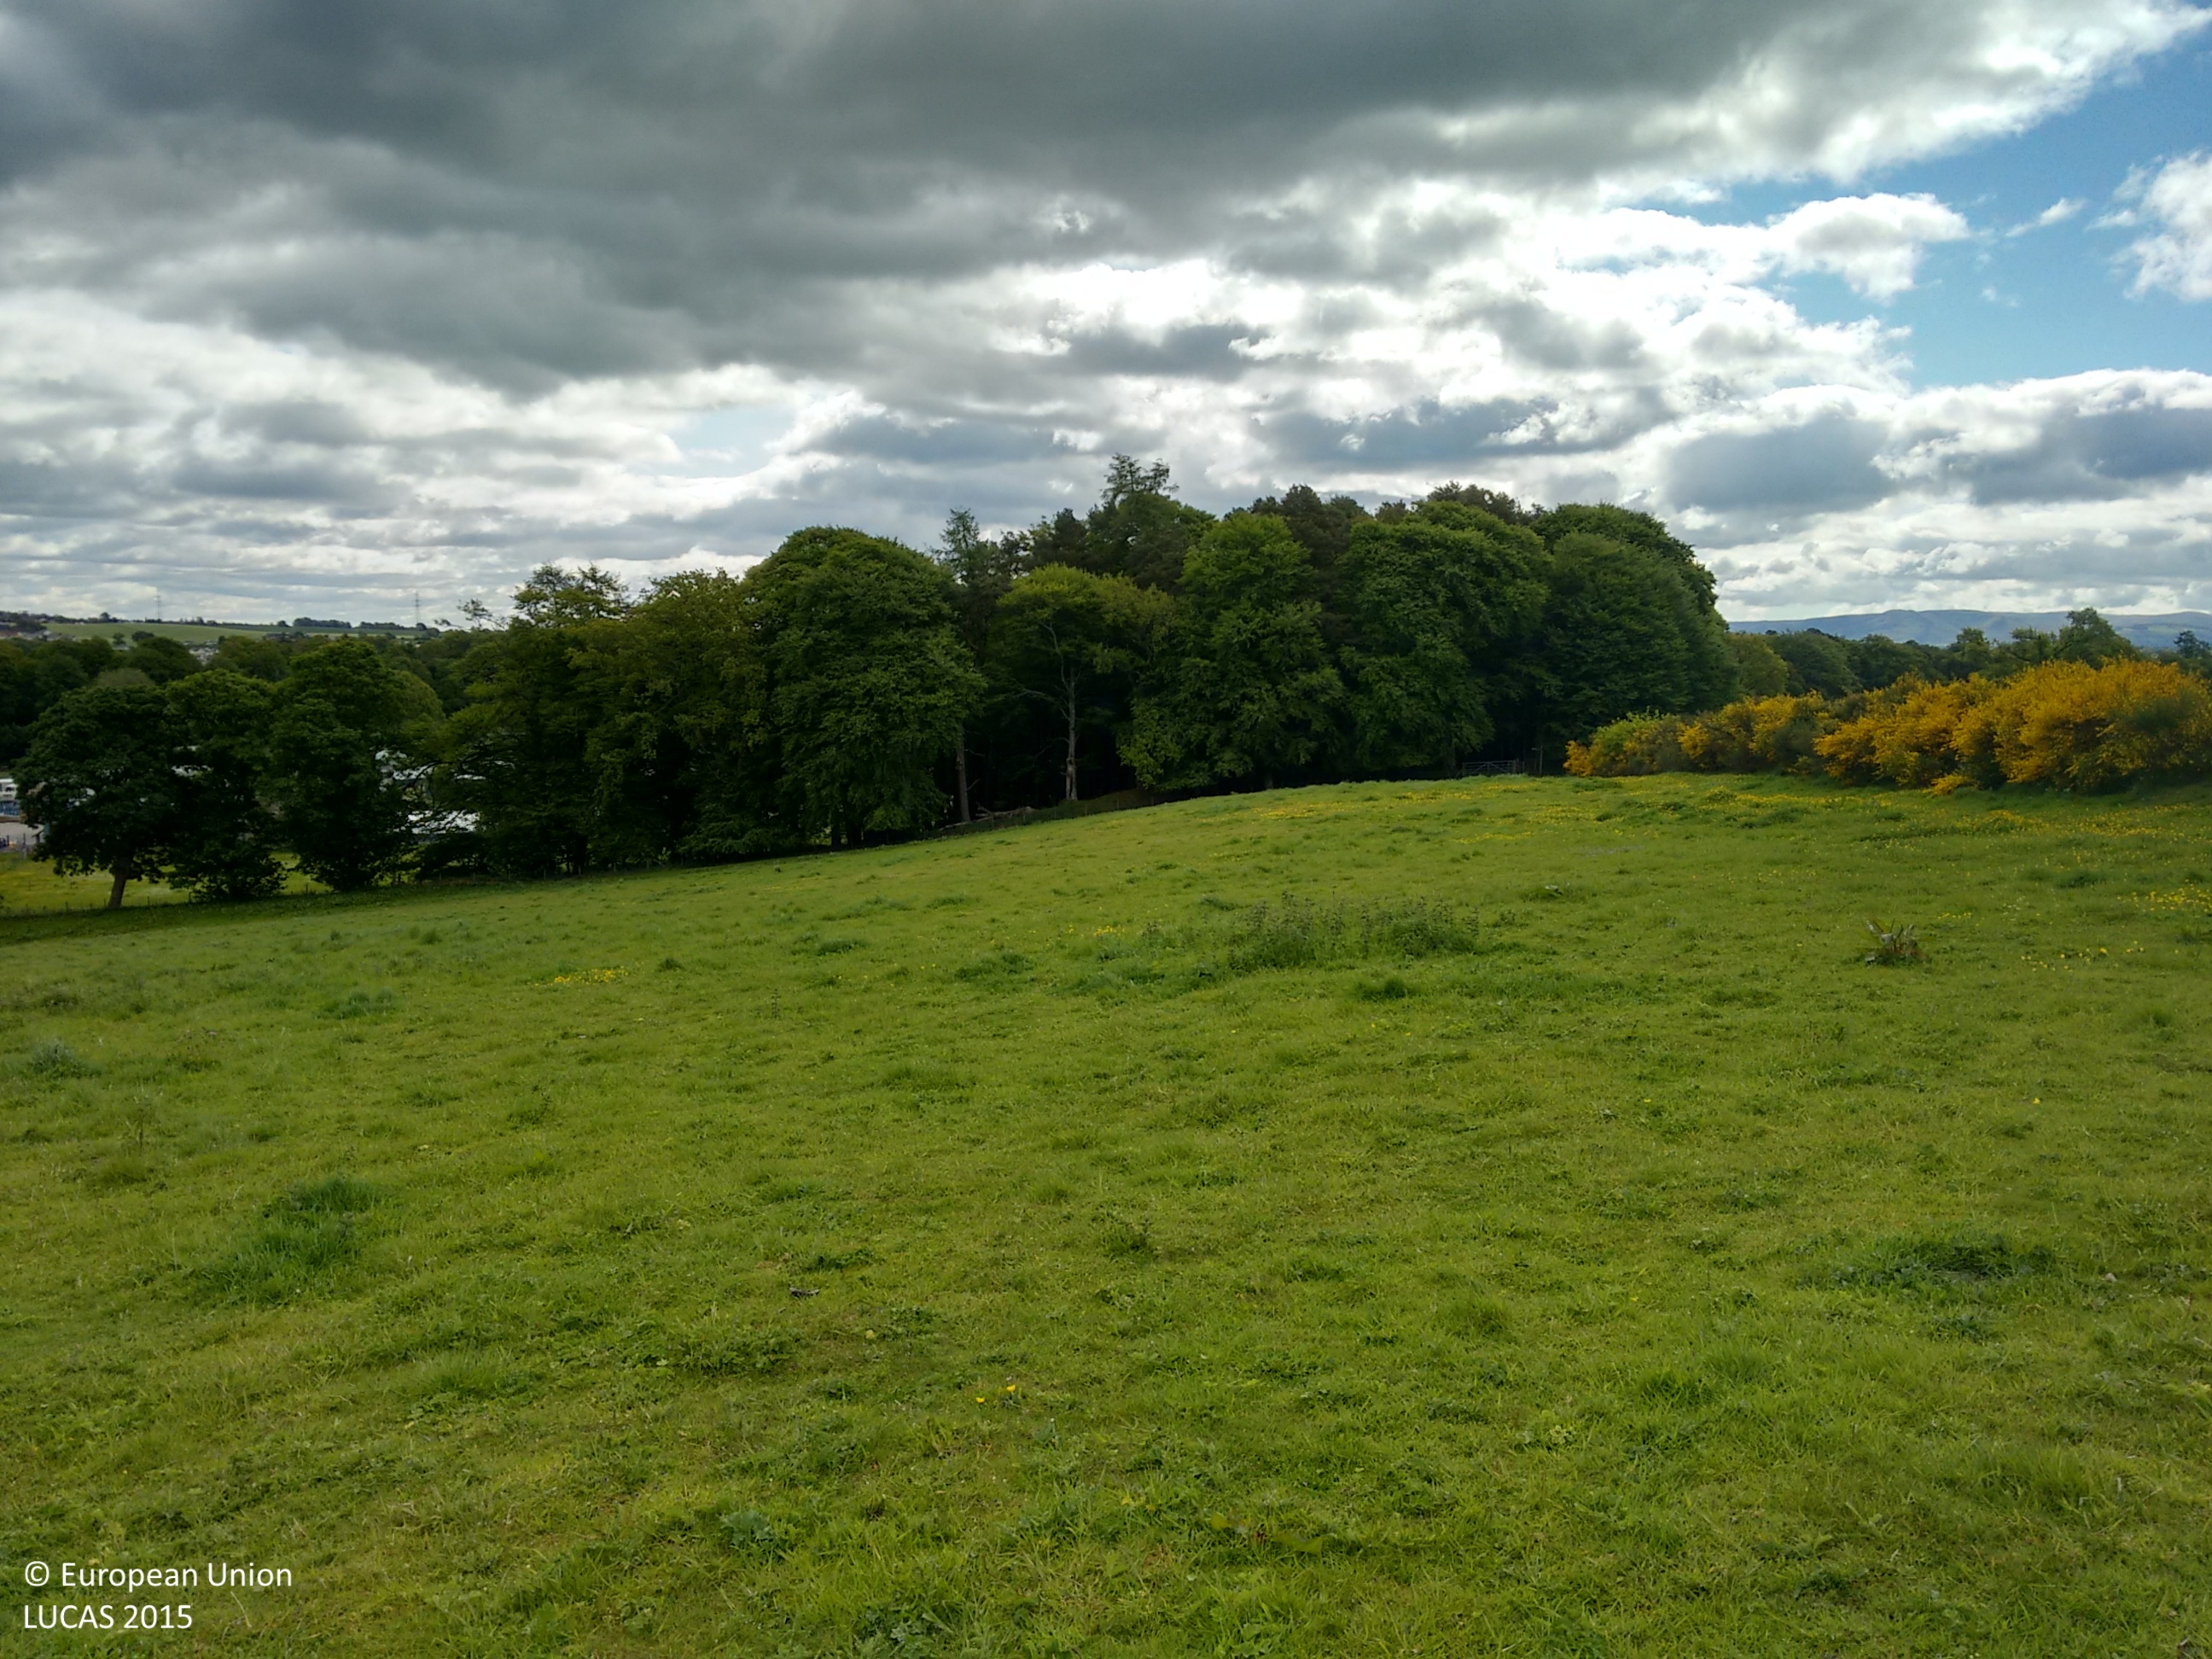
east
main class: Grassland
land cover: Grassland without tree/shrub cover
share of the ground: > 75 %
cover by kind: herbaceous plants 100 %
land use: Agriculture (excluding fallow land and kitchen gardens)
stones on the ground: 10 - 25 %
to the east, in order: Grassland without tree/shrub cover; Fences; Broadleaved woodland; Dry stone walls; Grass margins; Fences; Grassland without tree/shrub cover
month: June
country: GB
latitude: 56.3629
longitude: -3.8579
